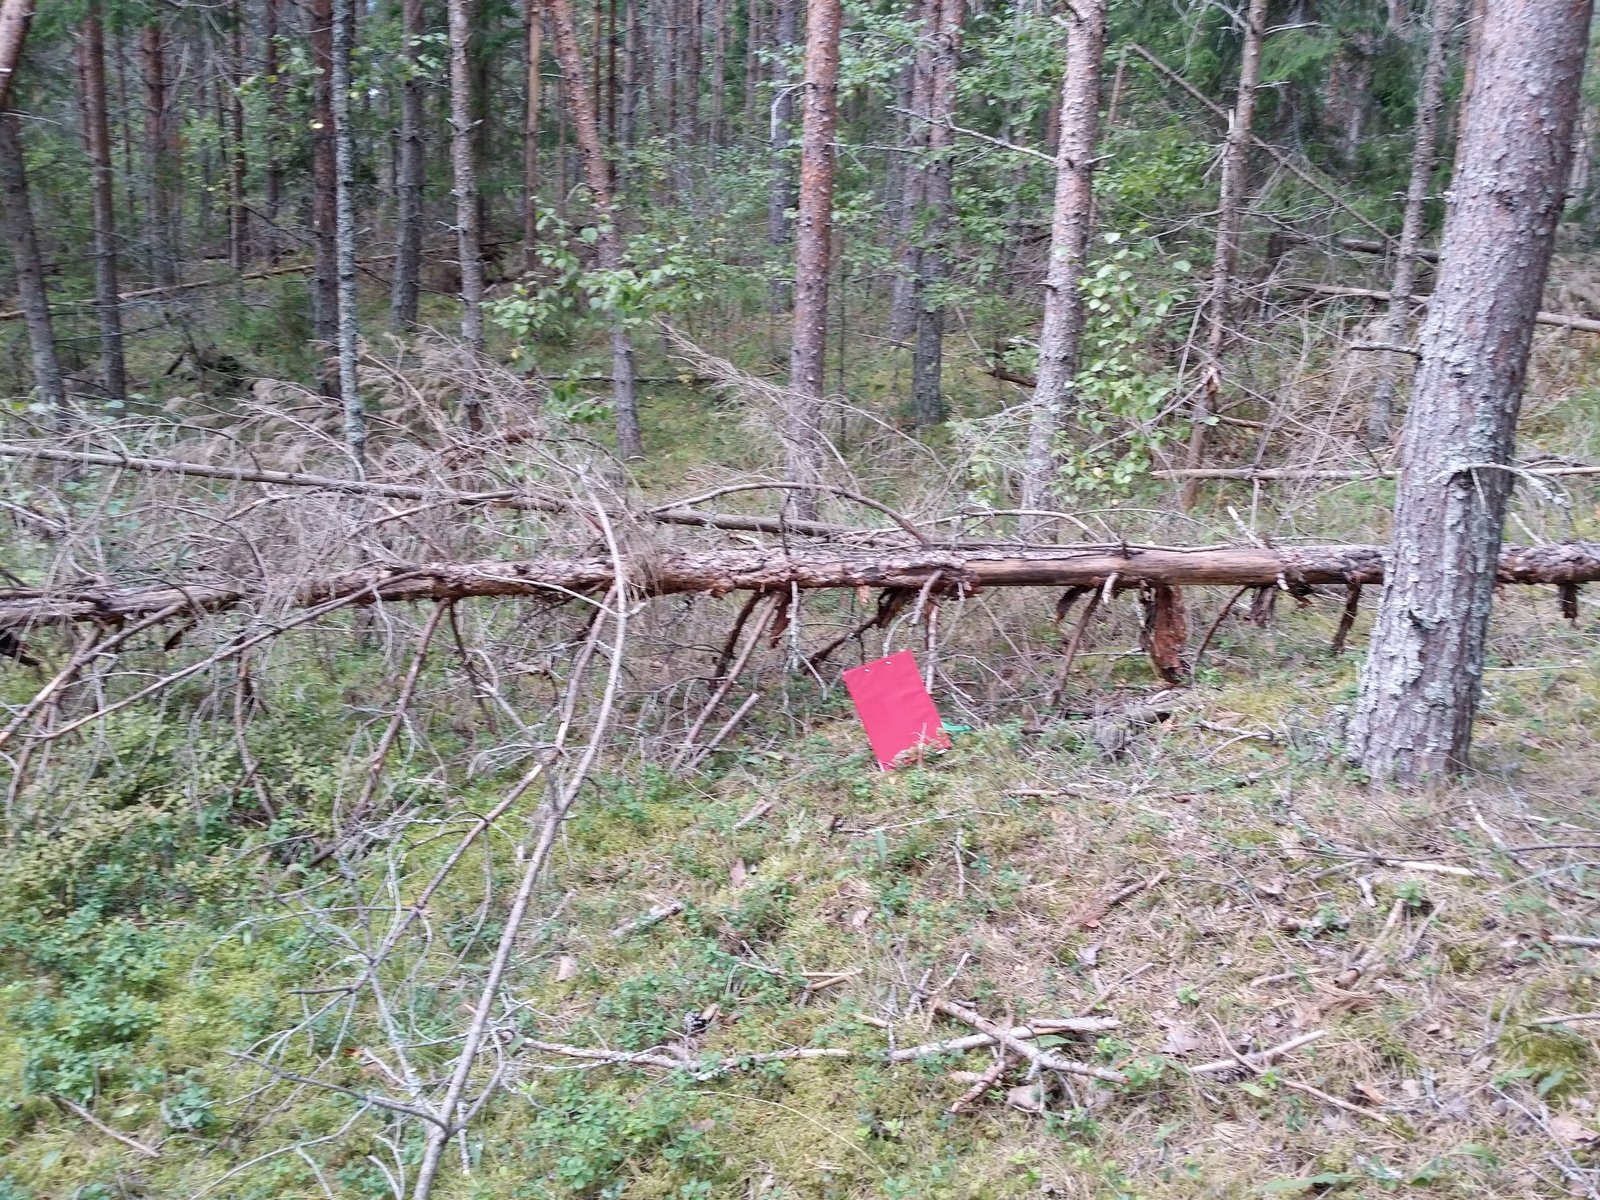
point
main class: Woodland
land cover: Other coniferous woodland
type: hemiboreal forest and nemoral coniferous forest and mixed broadleaved-coniferous forest
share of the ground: > 75 %
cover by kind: coniferous forest trees 80 %, shrubs 10 %, lichens and mosses 10 %
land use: Forestry
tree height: > 5 m
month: August
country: LV
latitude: 56.8737
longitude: 27.6223
